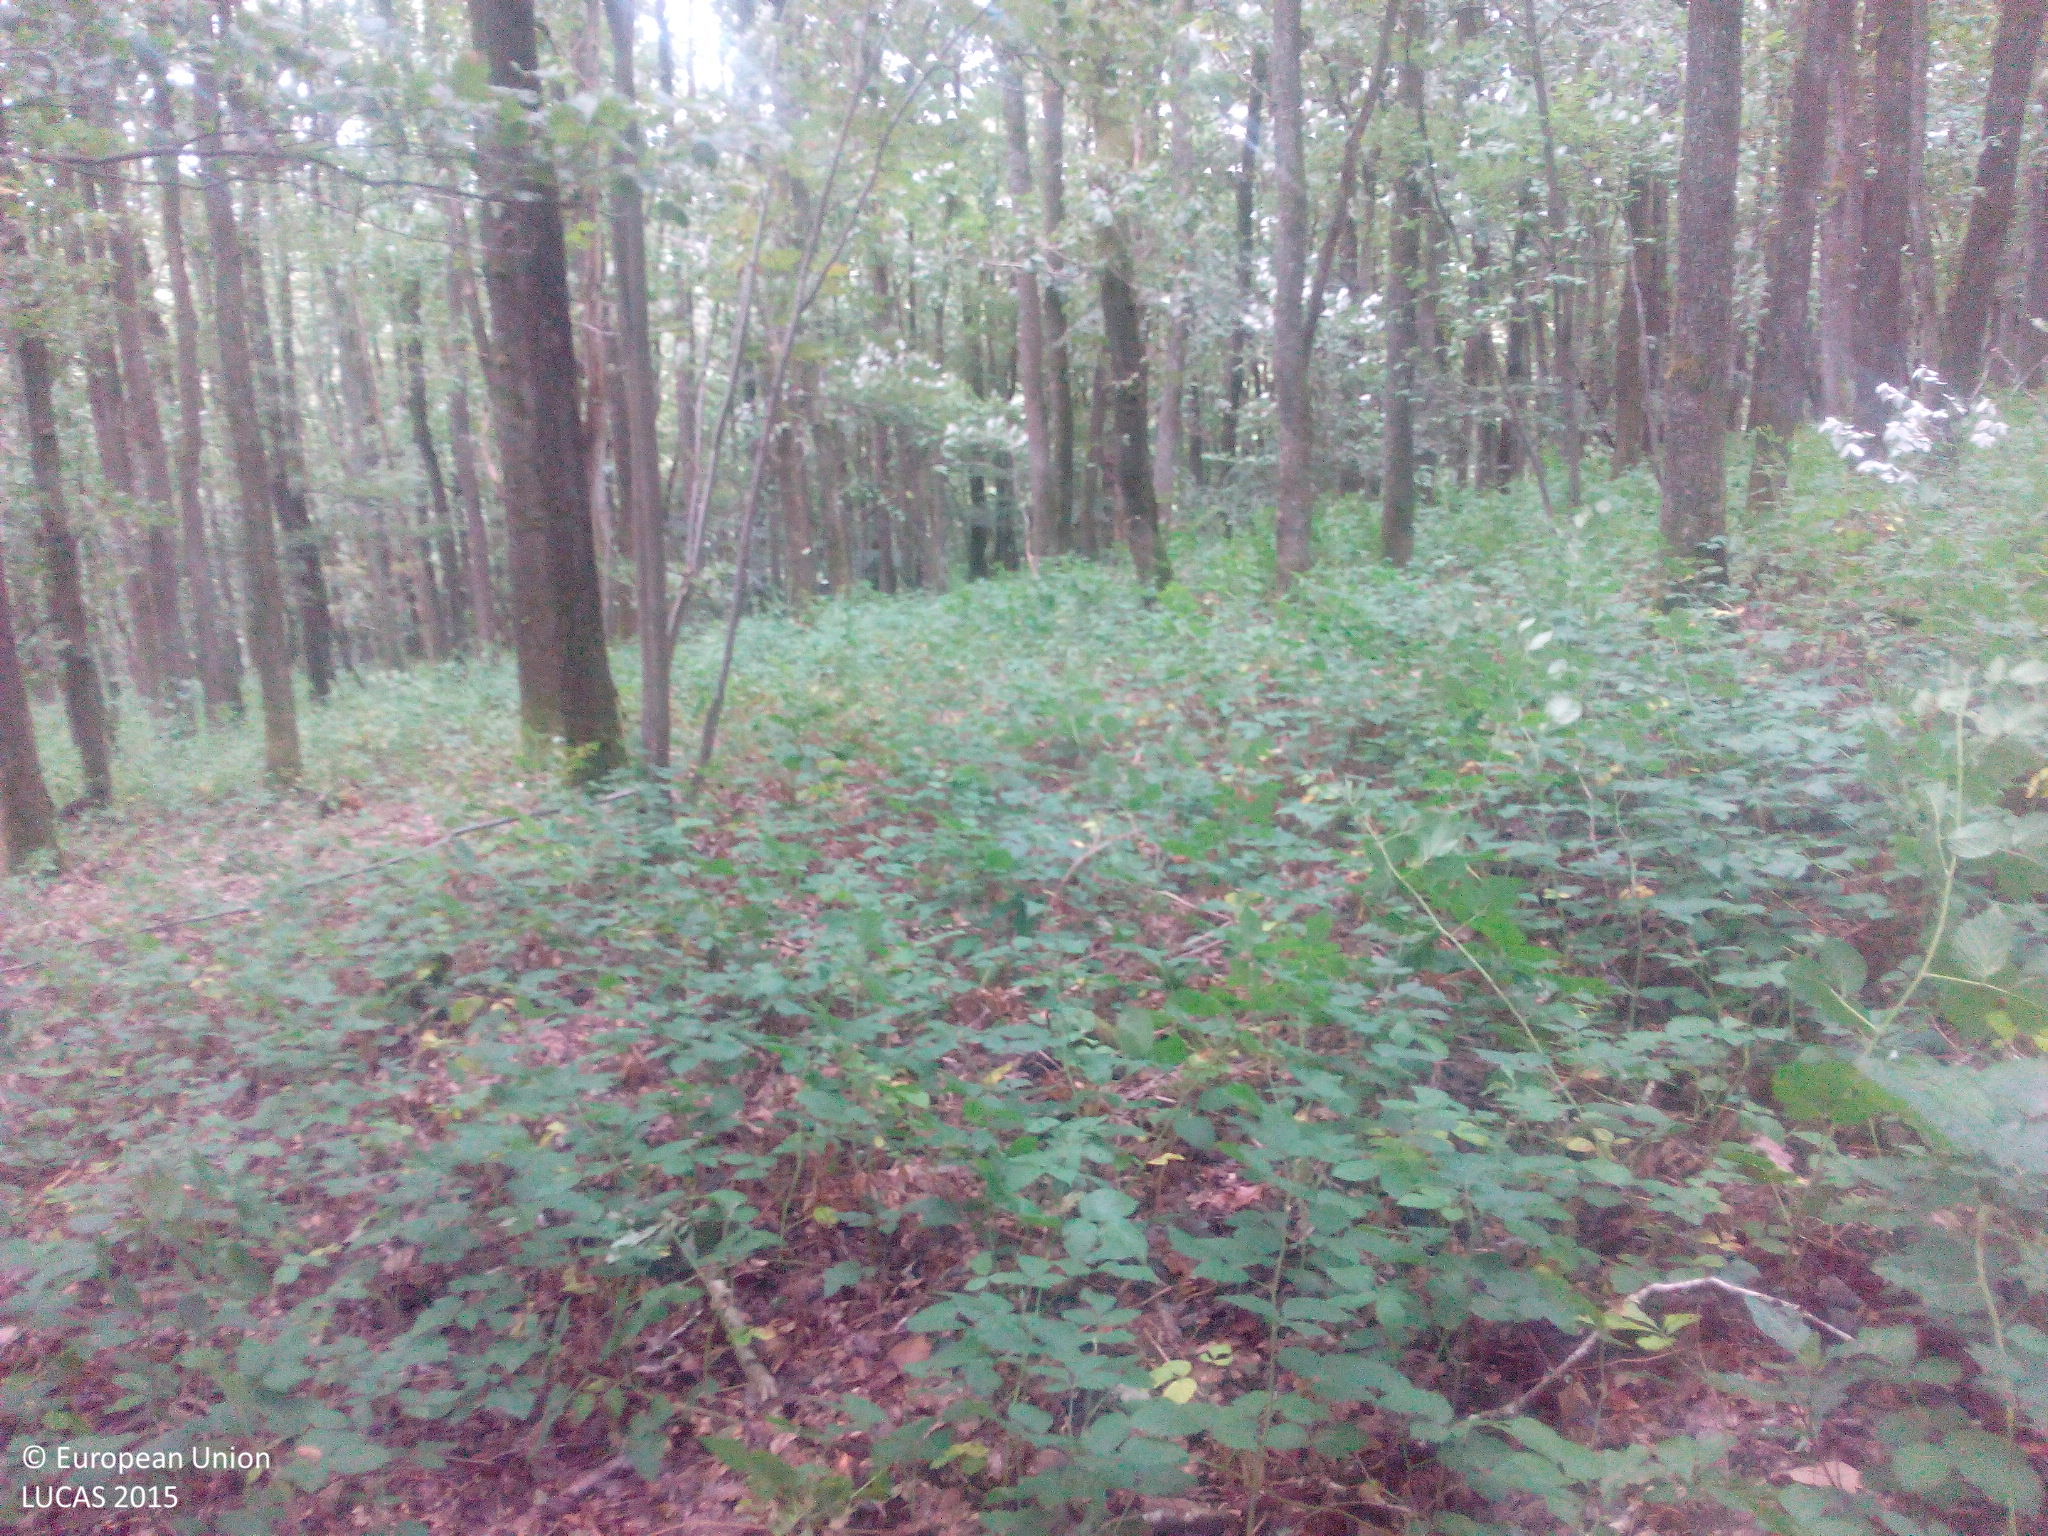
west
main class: Woodland
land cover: Broadleaved woodland
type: mesophytic deciduous forest
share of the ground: > 75 %
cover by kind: broadleaved forest trees 100 %
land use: Forestry
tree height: > 5 m
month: August
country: DE
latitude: 50.1779
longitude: 6.2886
